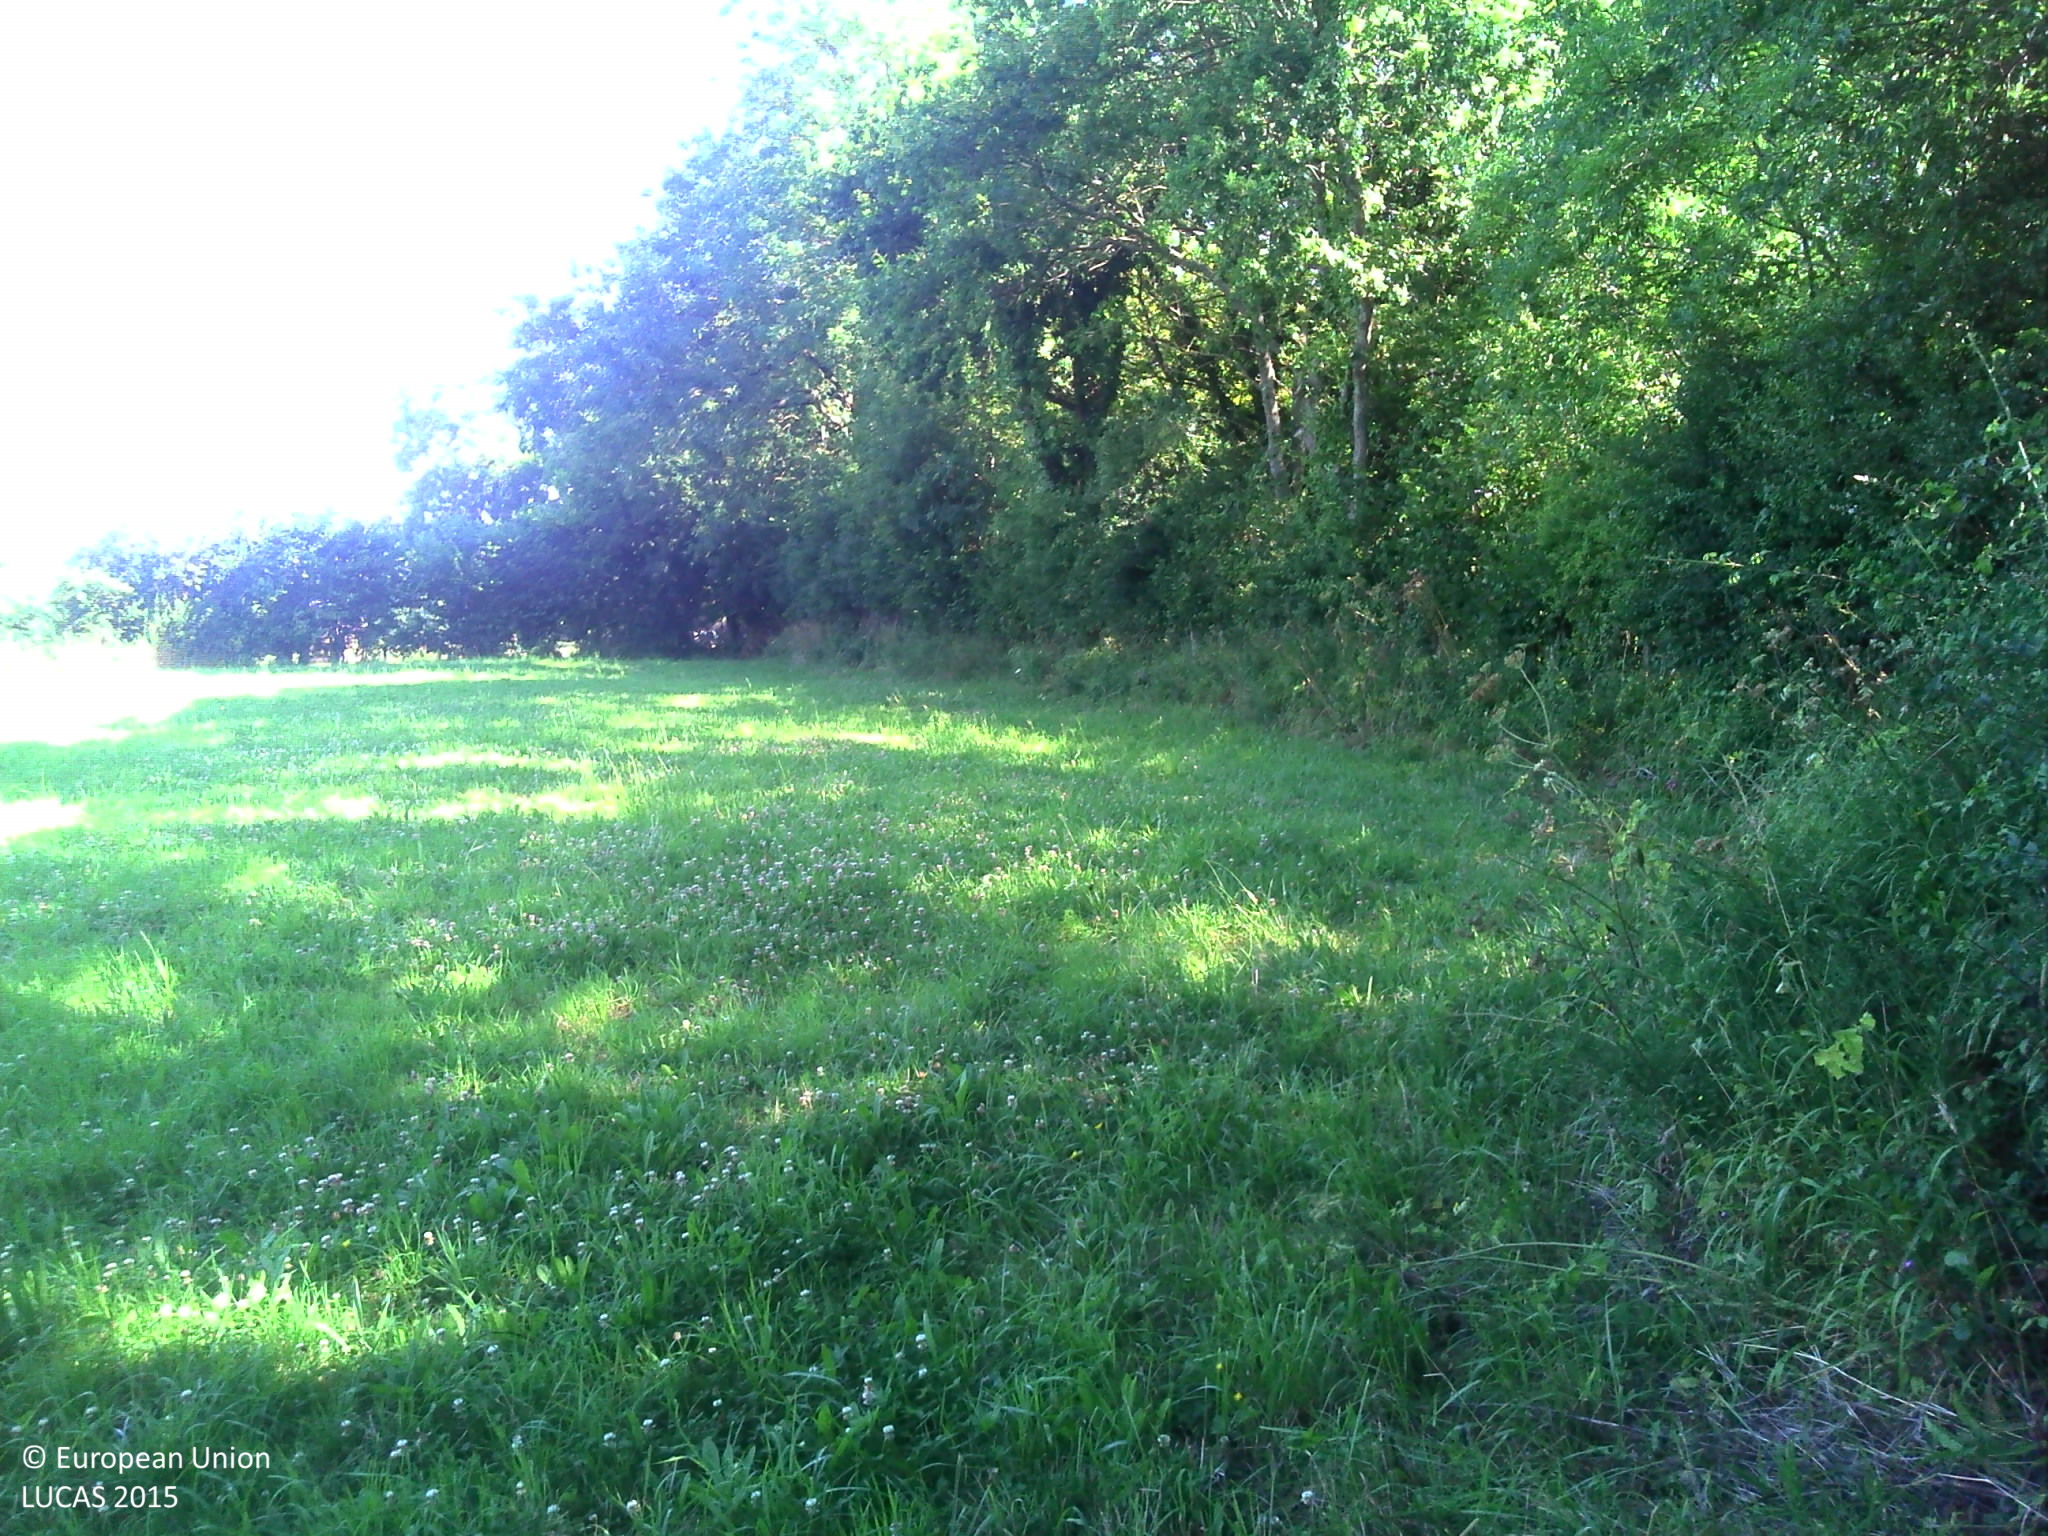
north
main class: Grassland
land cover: Grassland without tree/shrub cover
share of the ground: > 75 %
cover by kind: herbaceous plants 100 %
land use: Agriculture (excluding fallow land and kitchen gardens)
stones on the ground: < 10 %
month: July
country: FR
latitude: 49.0222
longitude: -1.4666
